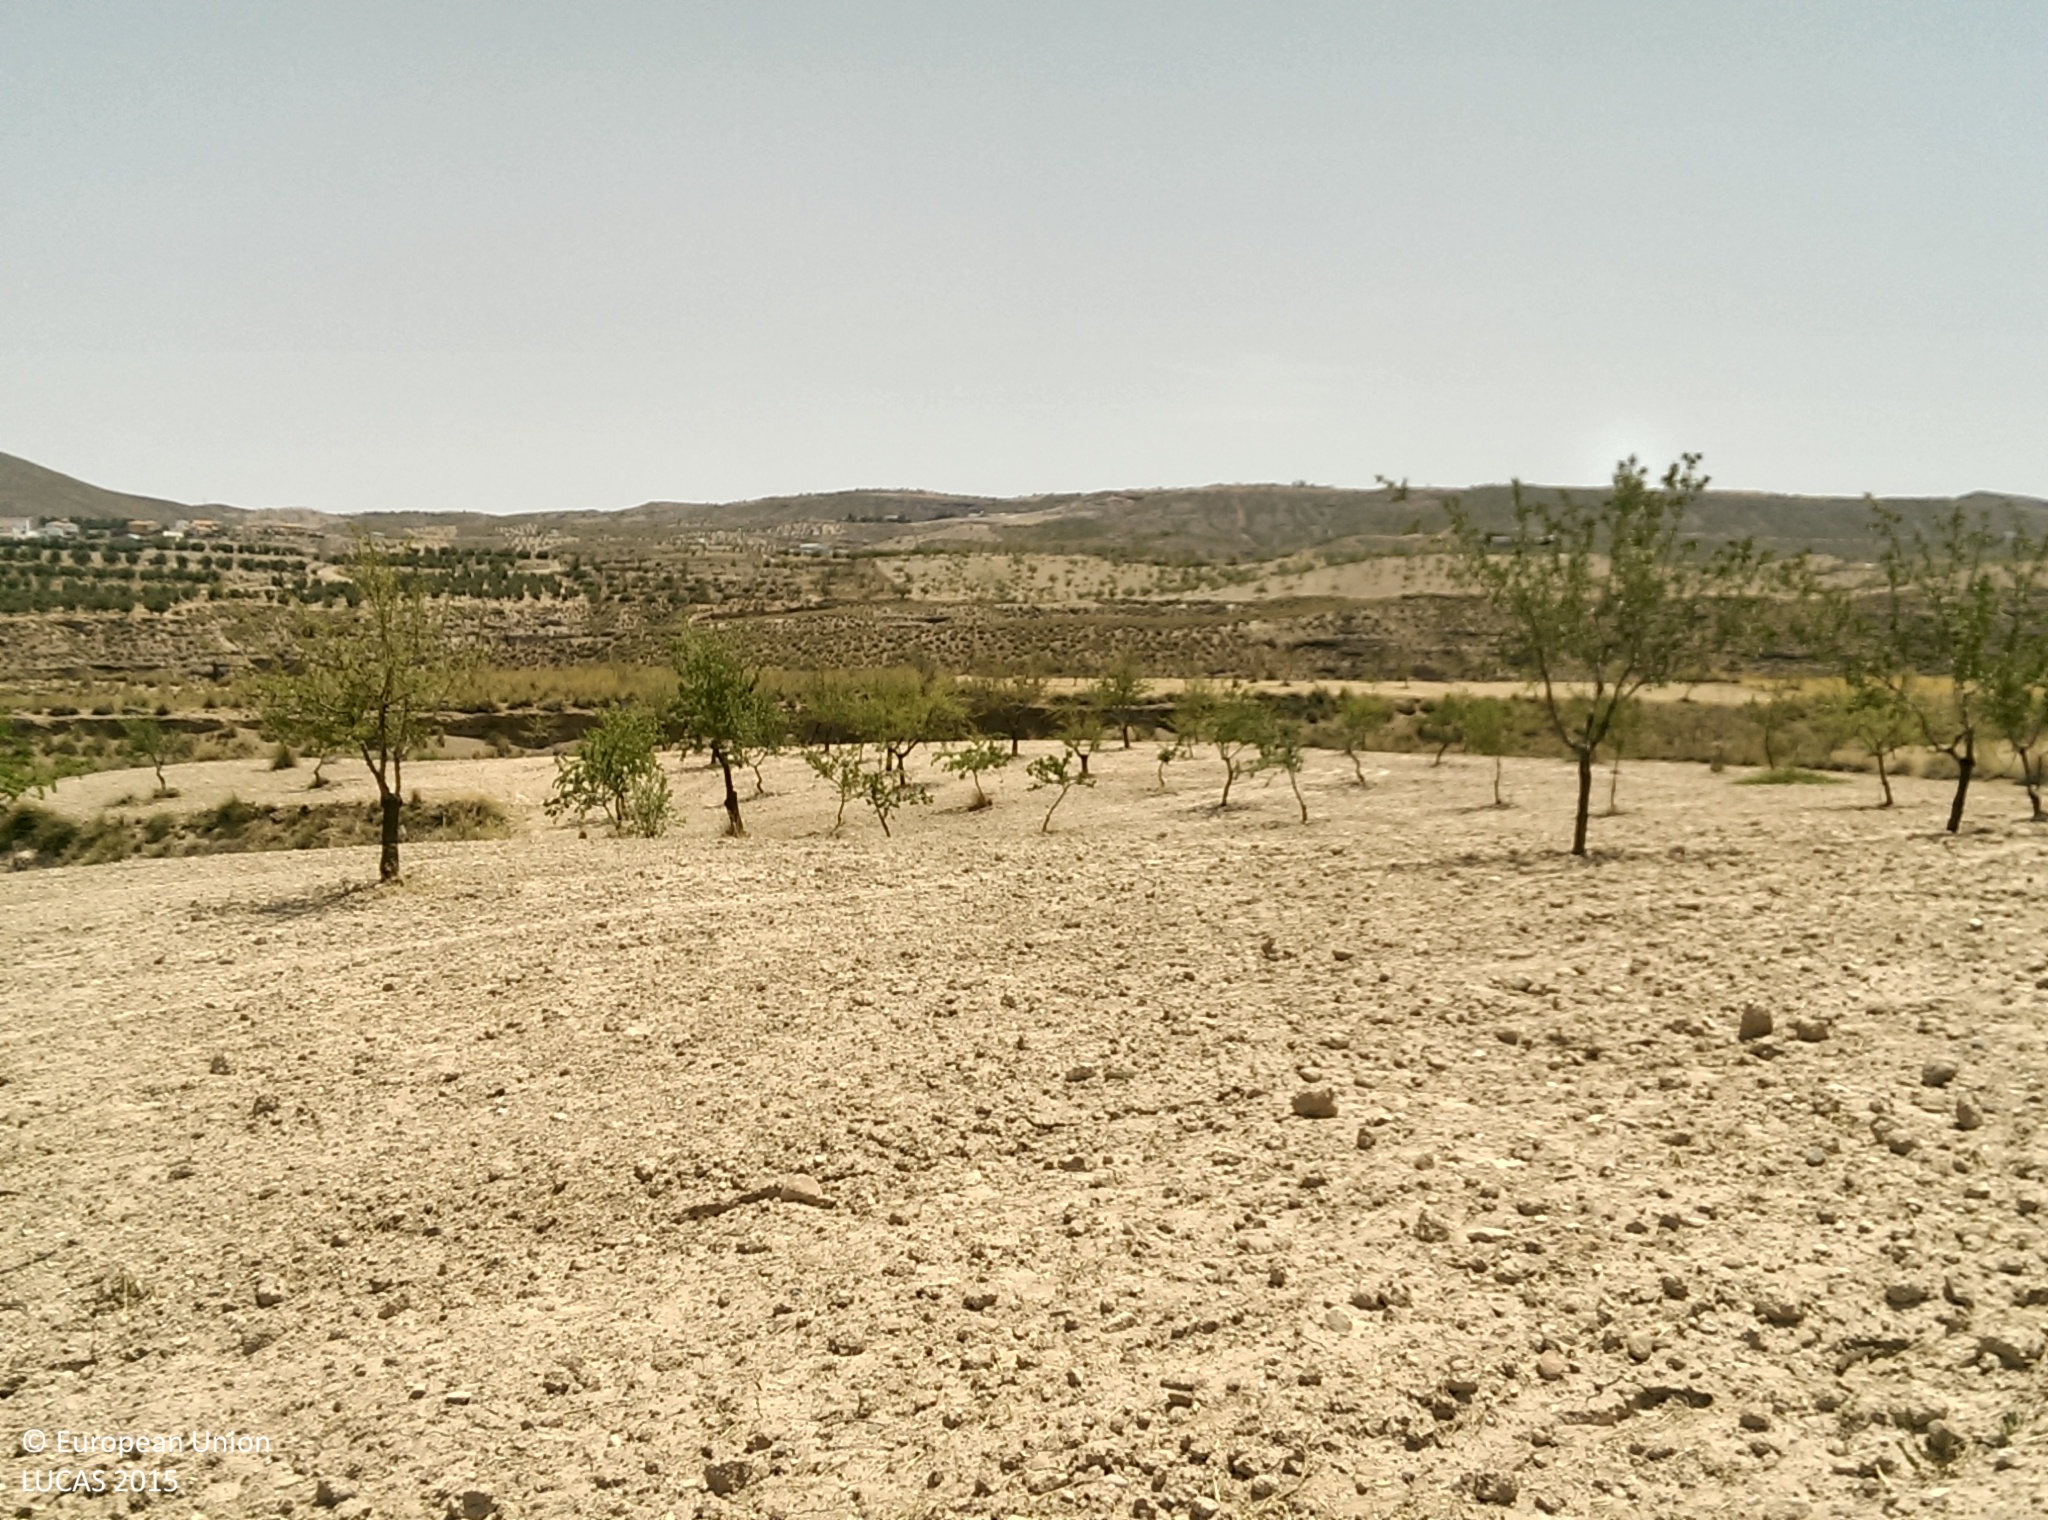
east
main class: Cropland
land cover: Nuts trees
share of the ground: < 10 %
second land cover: Other bare soil
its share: > 75 %
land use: Agriculture (excluding fallow land and kitchen gardens)
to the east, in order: Nuts trees; Other bare soil; Grassland without tree/shrub cover; Other structural elements; Grassland without tree/shrub cover; Inland fresh running water
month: July
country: ES
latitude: 37.5222
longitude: -2.9216
